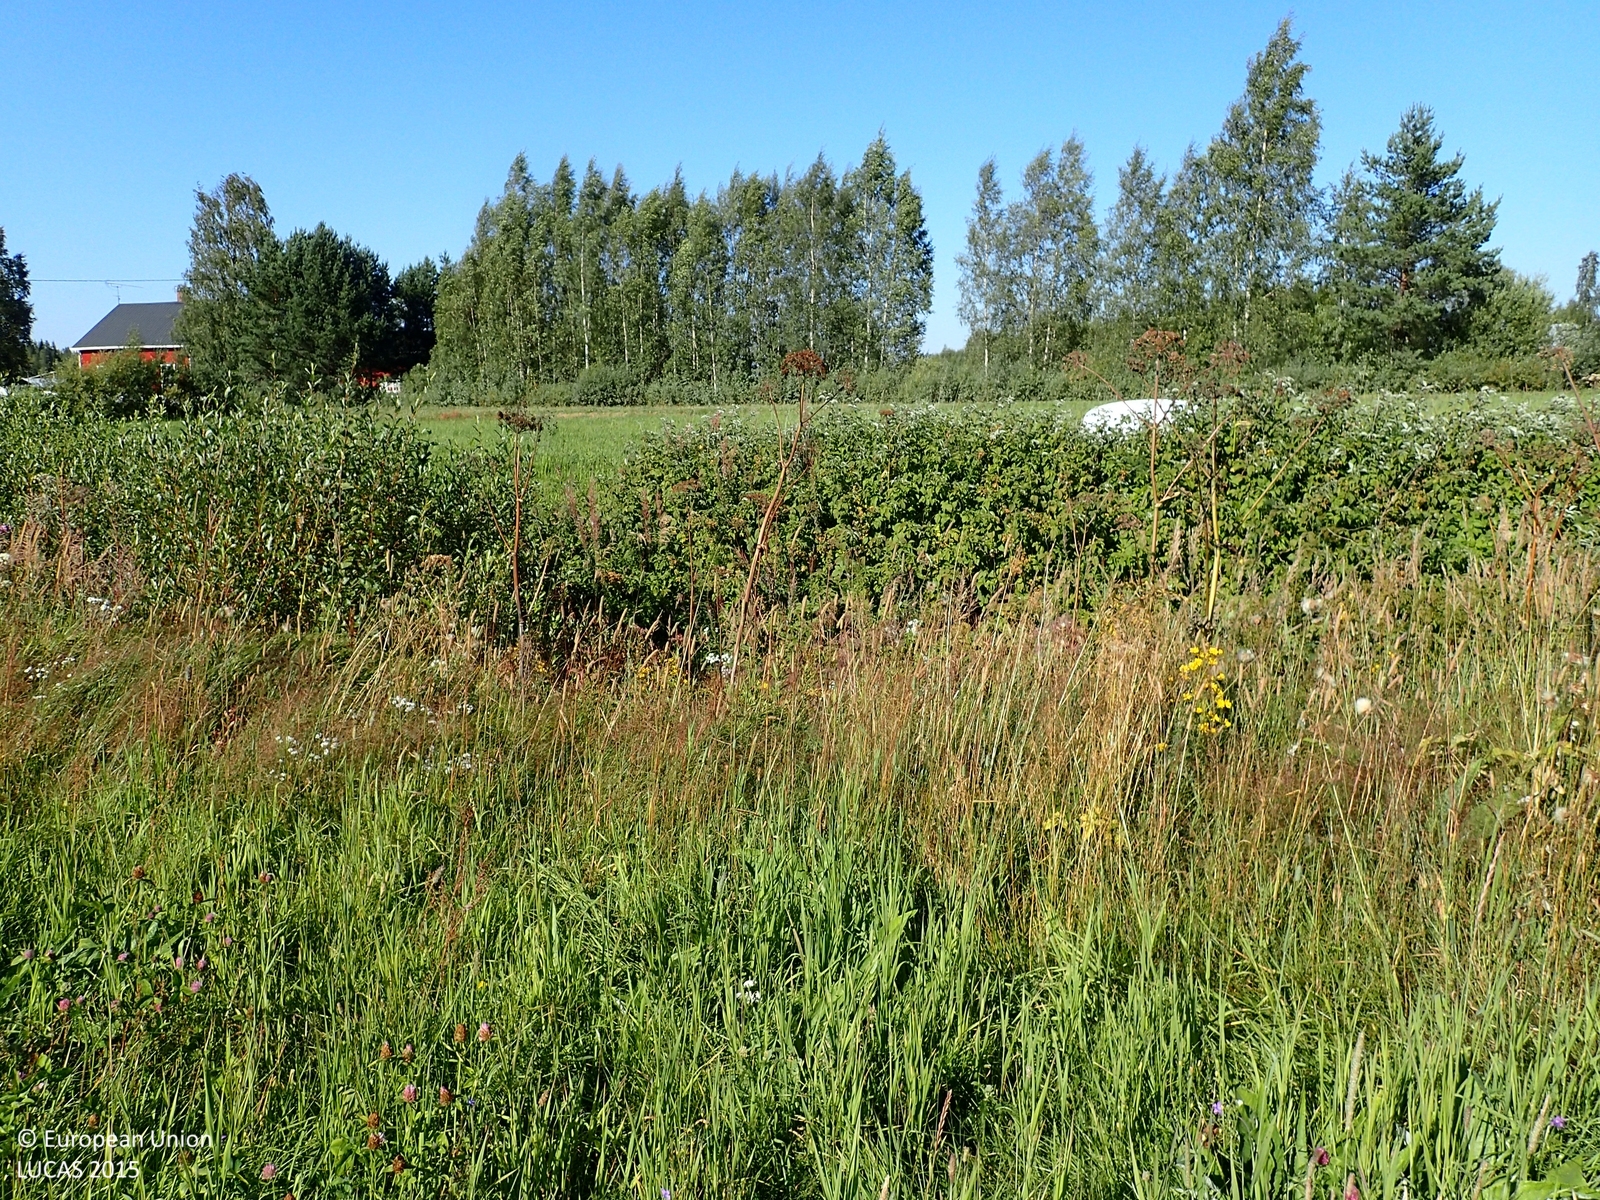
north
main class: Cropland
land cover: Temporary grasslands
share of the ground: > 75 %
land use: Agriculture (excluding fallow land and kitchen gardens)
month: August
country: FI
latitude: 62.3969
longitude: 21.8687
